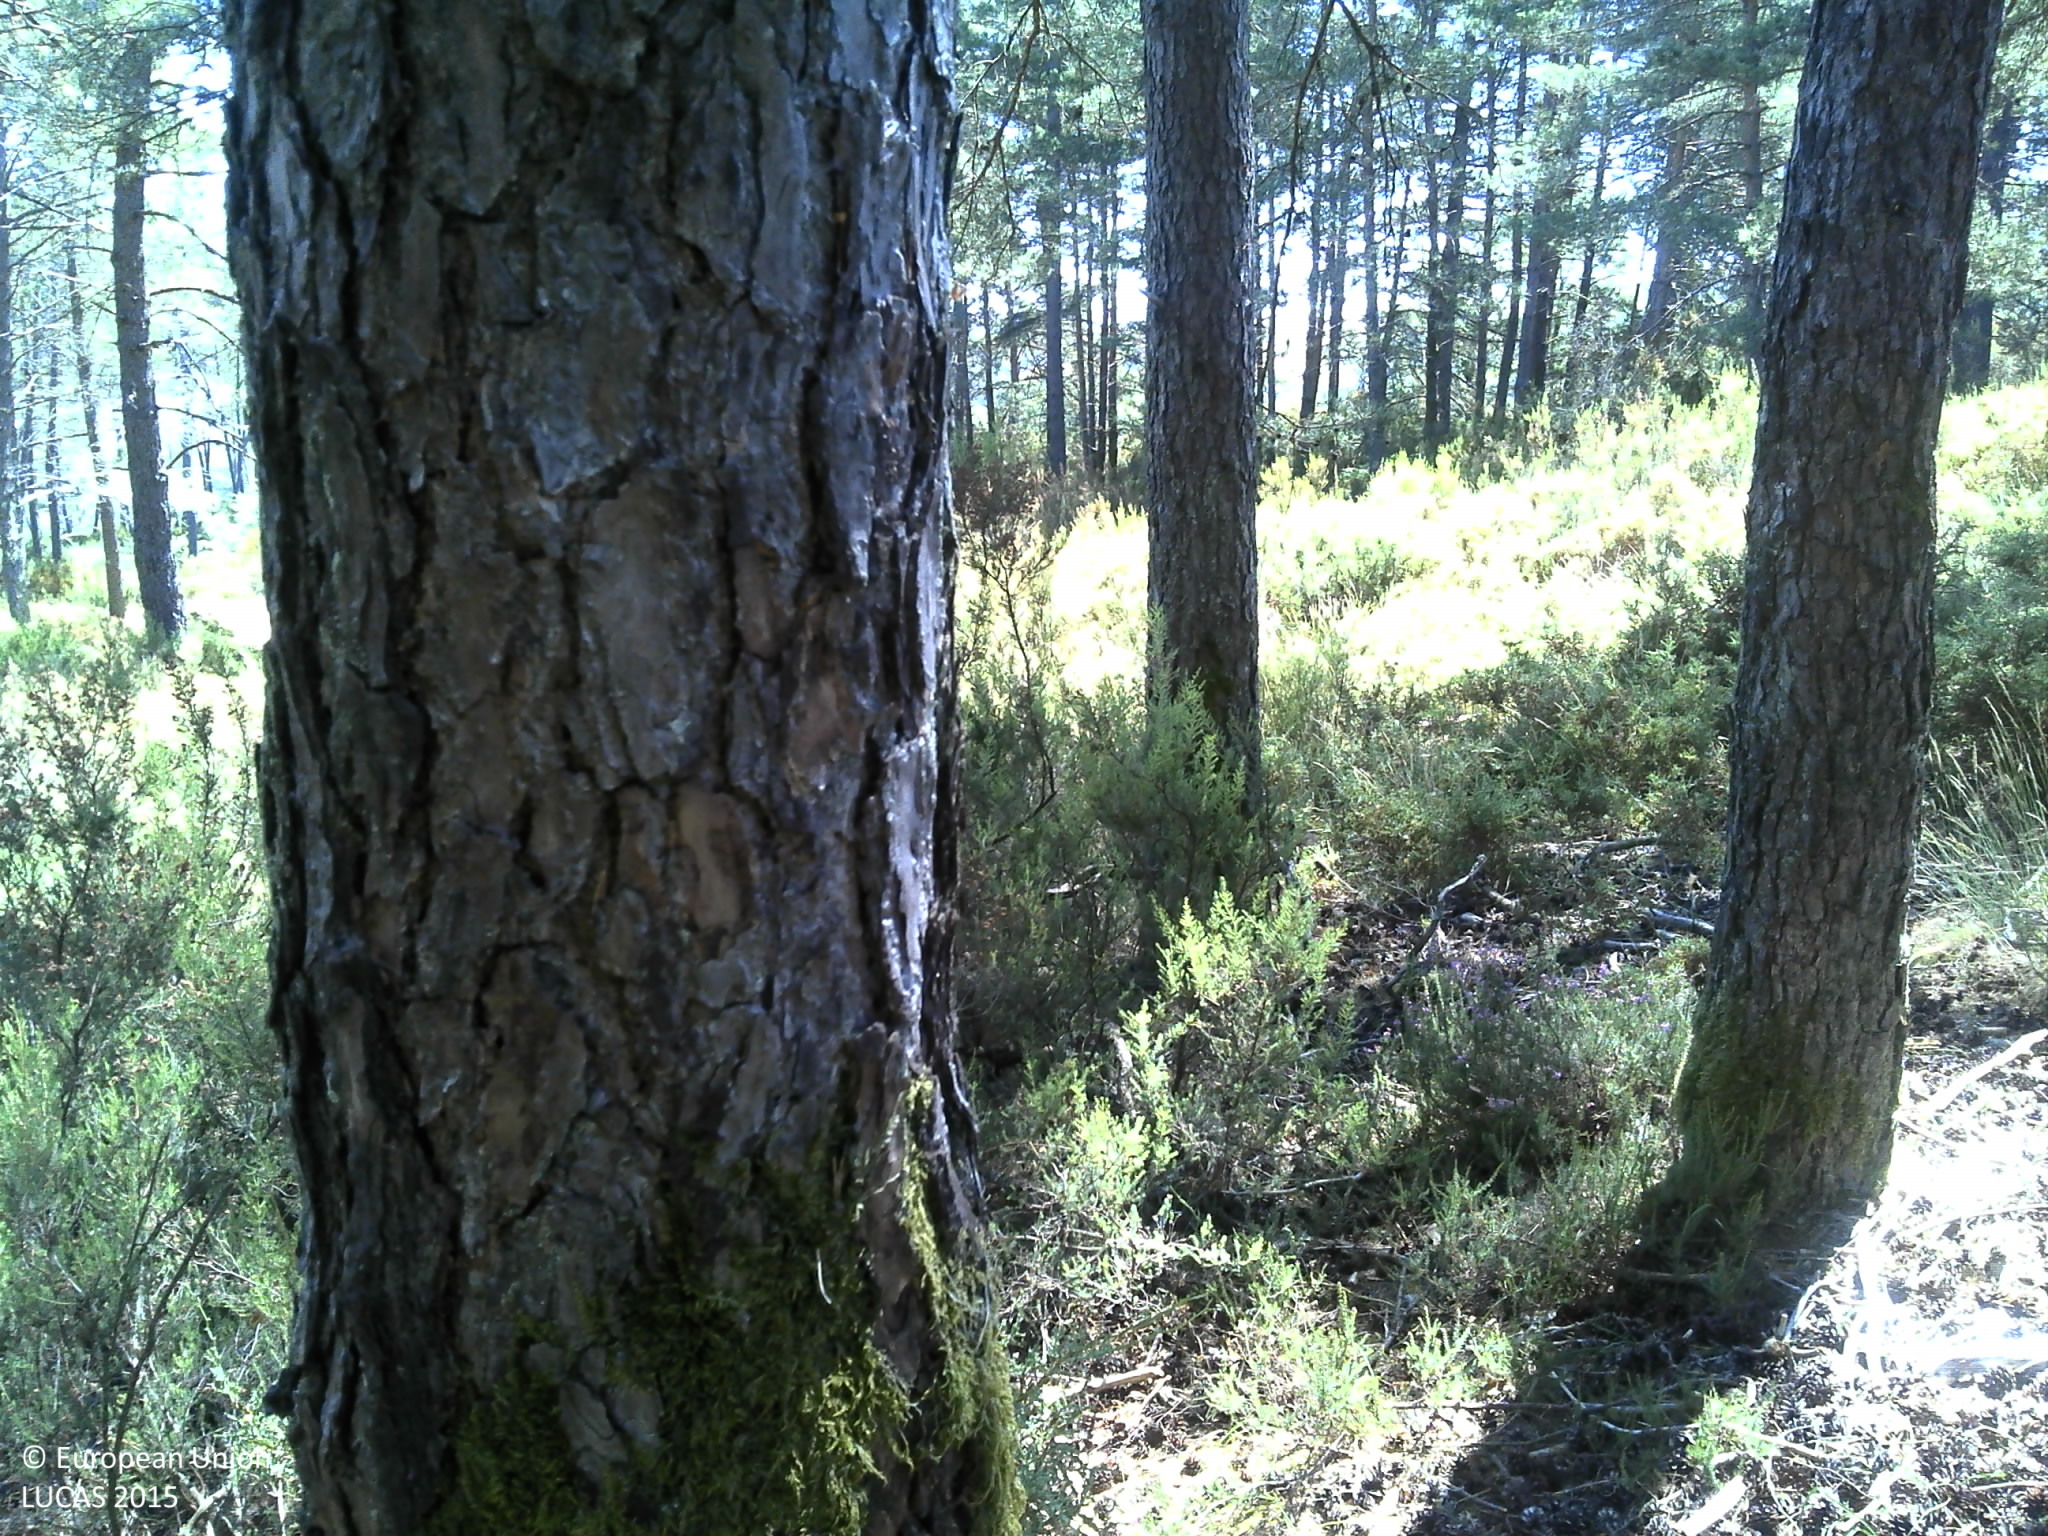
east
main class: Woodland
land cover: Pine dominated coniferous woodland
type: coniferous forest of the mediterranean region
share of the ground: > 75 %
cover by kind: coniferous forest trees 90 %, shrubs 5 %, unconsolidated bare surface 5 %
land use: Forestry
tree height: > 5 m
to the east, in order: Pine dominated coniferous woodland; Shrubland without tree cover; Pine dominated coniferous woodland; Shrubland with sparse tree cover; Broadleaved woodland; Shrubland without tree cover; Dry stone walls; Shrubland without tree cover; Pine dominated coniferous woodland
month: July
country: PT
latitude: 41.4949
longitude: -7.7544
